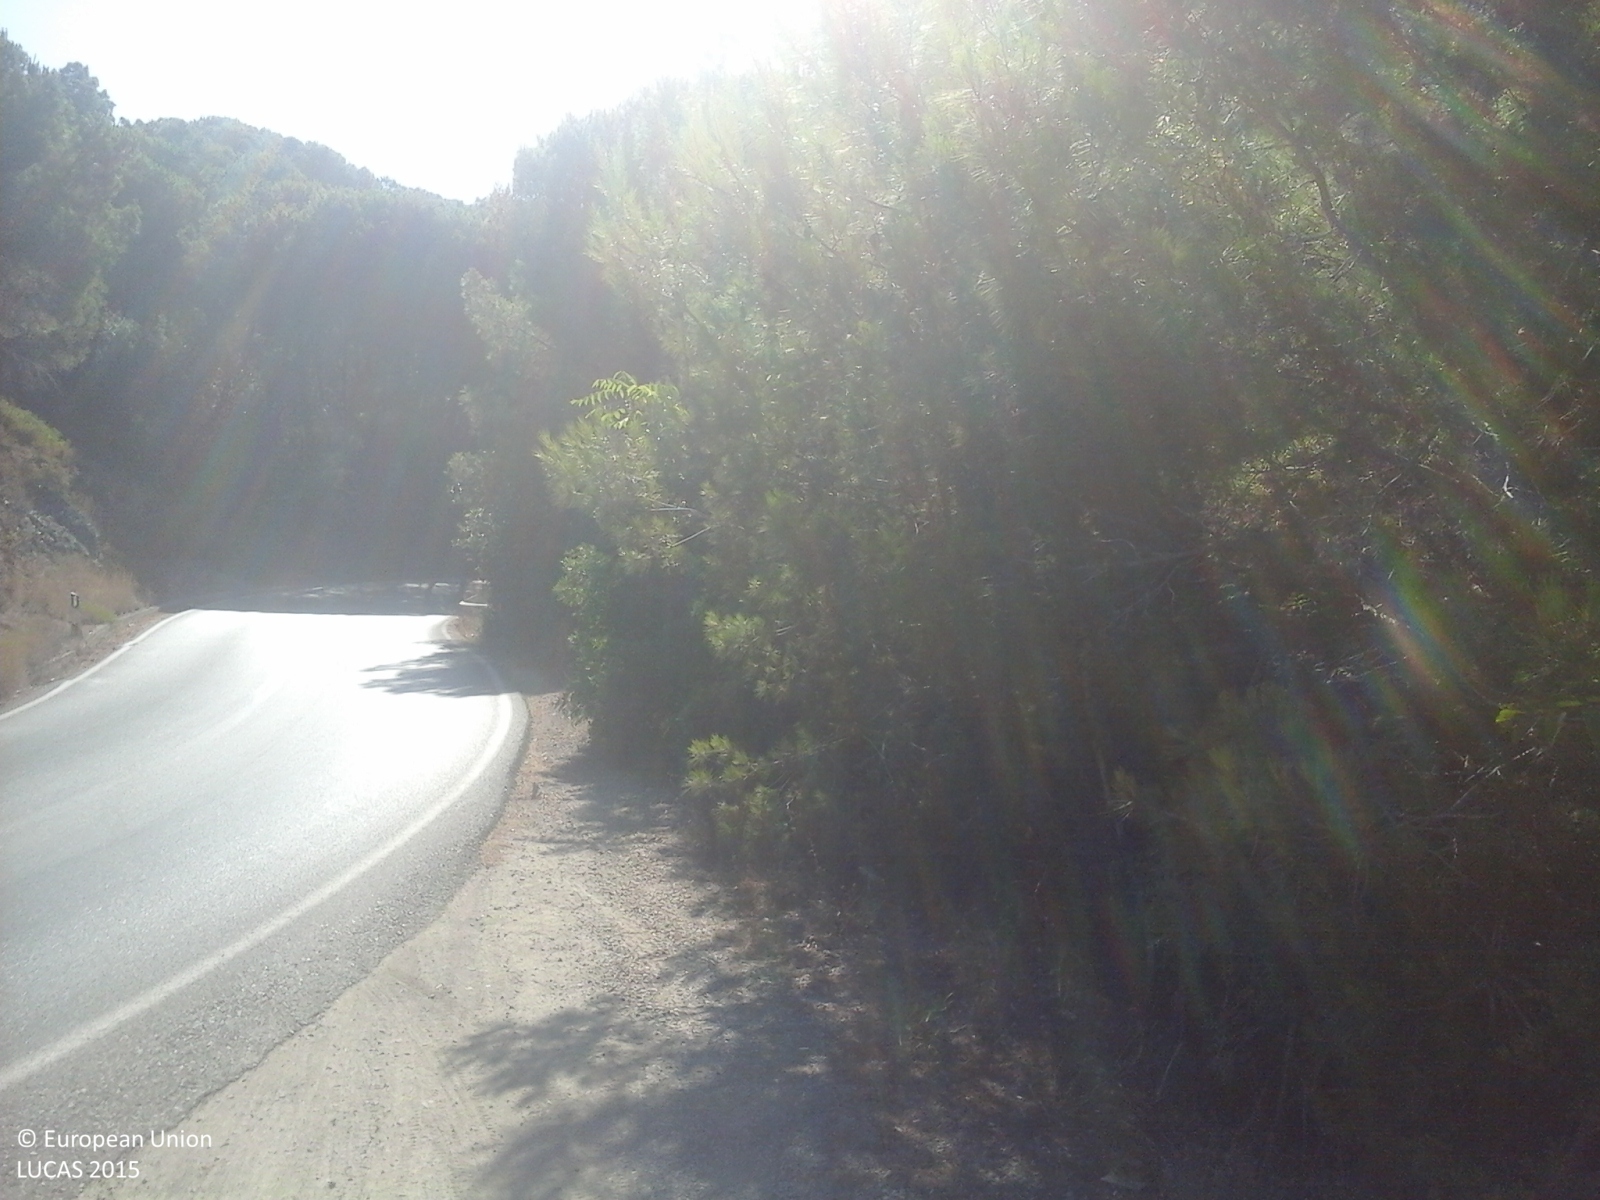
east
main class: Woodland
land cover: Pine dominated mixed woodland
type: coniferous forest of the mediterranean region
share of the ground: > 75 %
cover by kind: broadleaved forest trees 75 %, coniferous forest trees 25 %
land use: Semi-natural and natural areas not in use
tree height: > 5 m
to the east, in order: Pine dominated mixed woodland; Tracks; Pine dominated mixed woodland
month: July
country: IT
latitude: 42.7618
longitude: 10.3288
